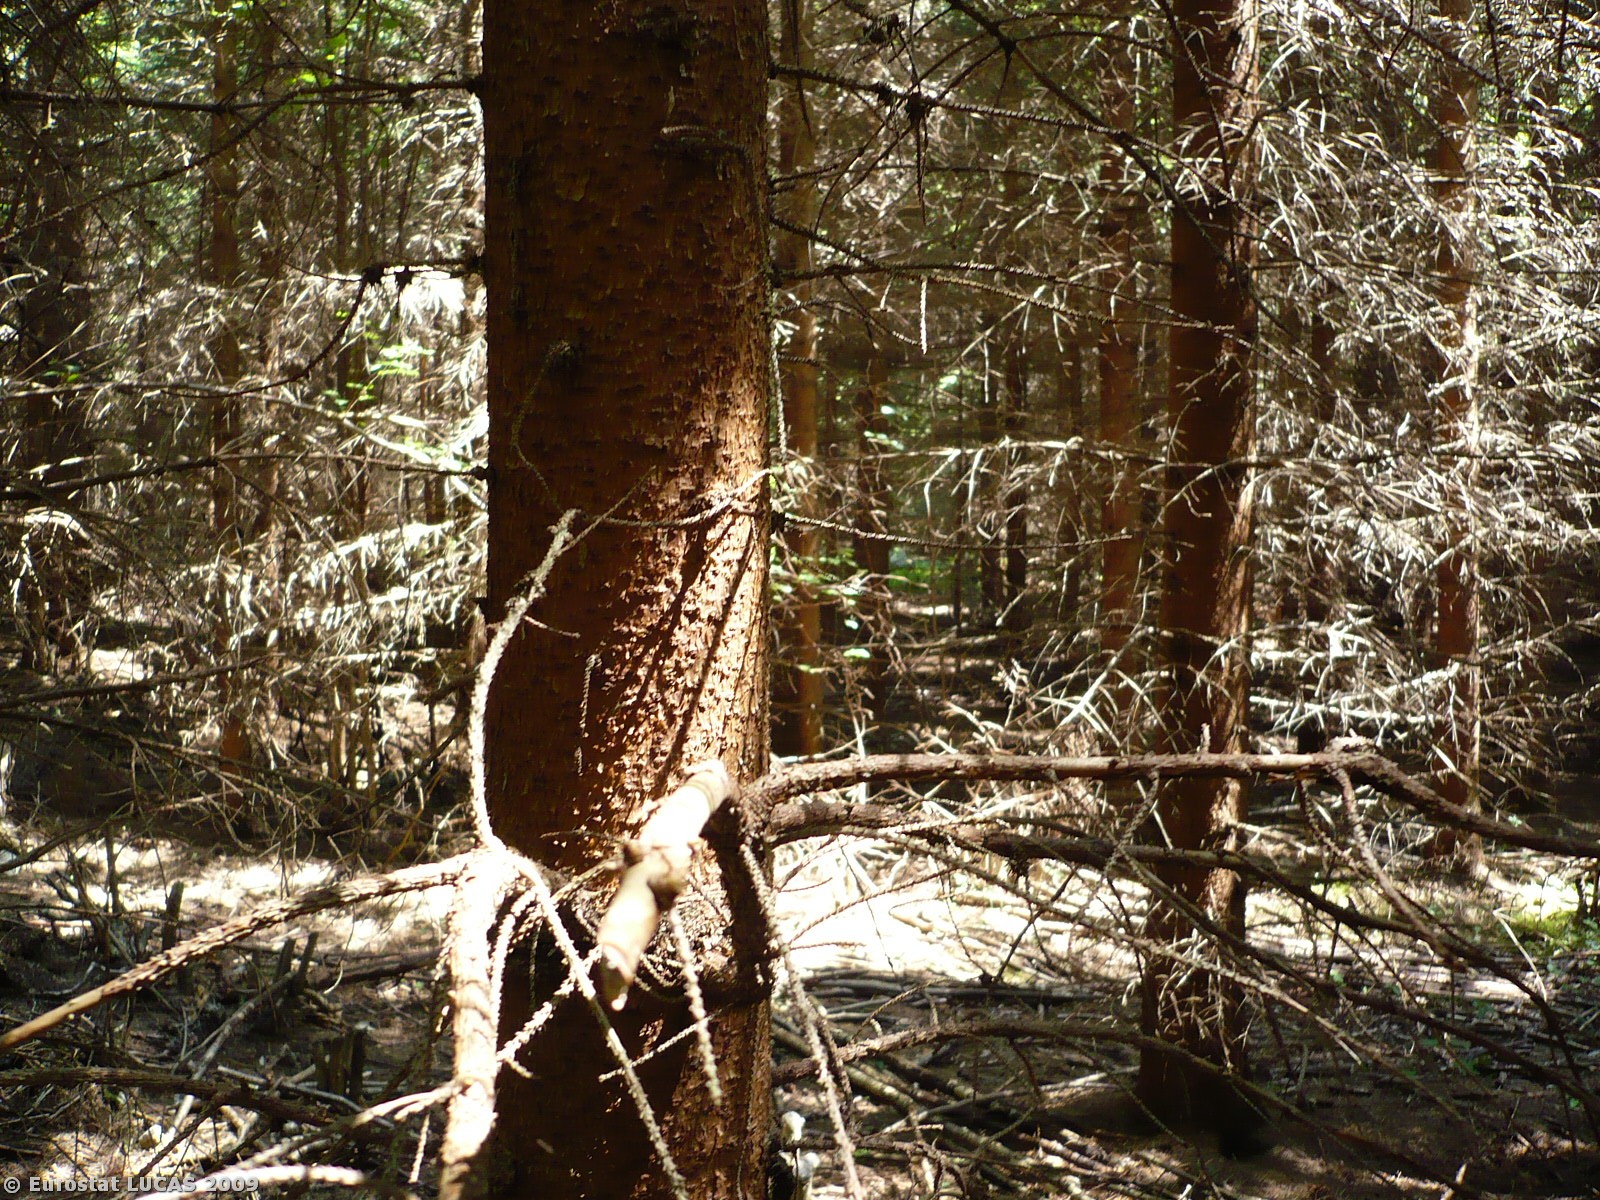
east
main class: Woodland
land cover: Coniferous woodland
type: hemiboreal forest and nemoral coniferous forest and mixed broadleaved-coniferous forest
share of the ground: > 75 %
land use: Forestry
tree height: > 5 m
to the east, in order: Coniferous woodland; Spontaneously vegetated surfaces; Coniferous woodland; Tracks; Coniferous woodland; Mixed woodland; Tracks; Mixed woodland
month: July
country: SI
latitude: 45.6866
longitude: 14.3228
